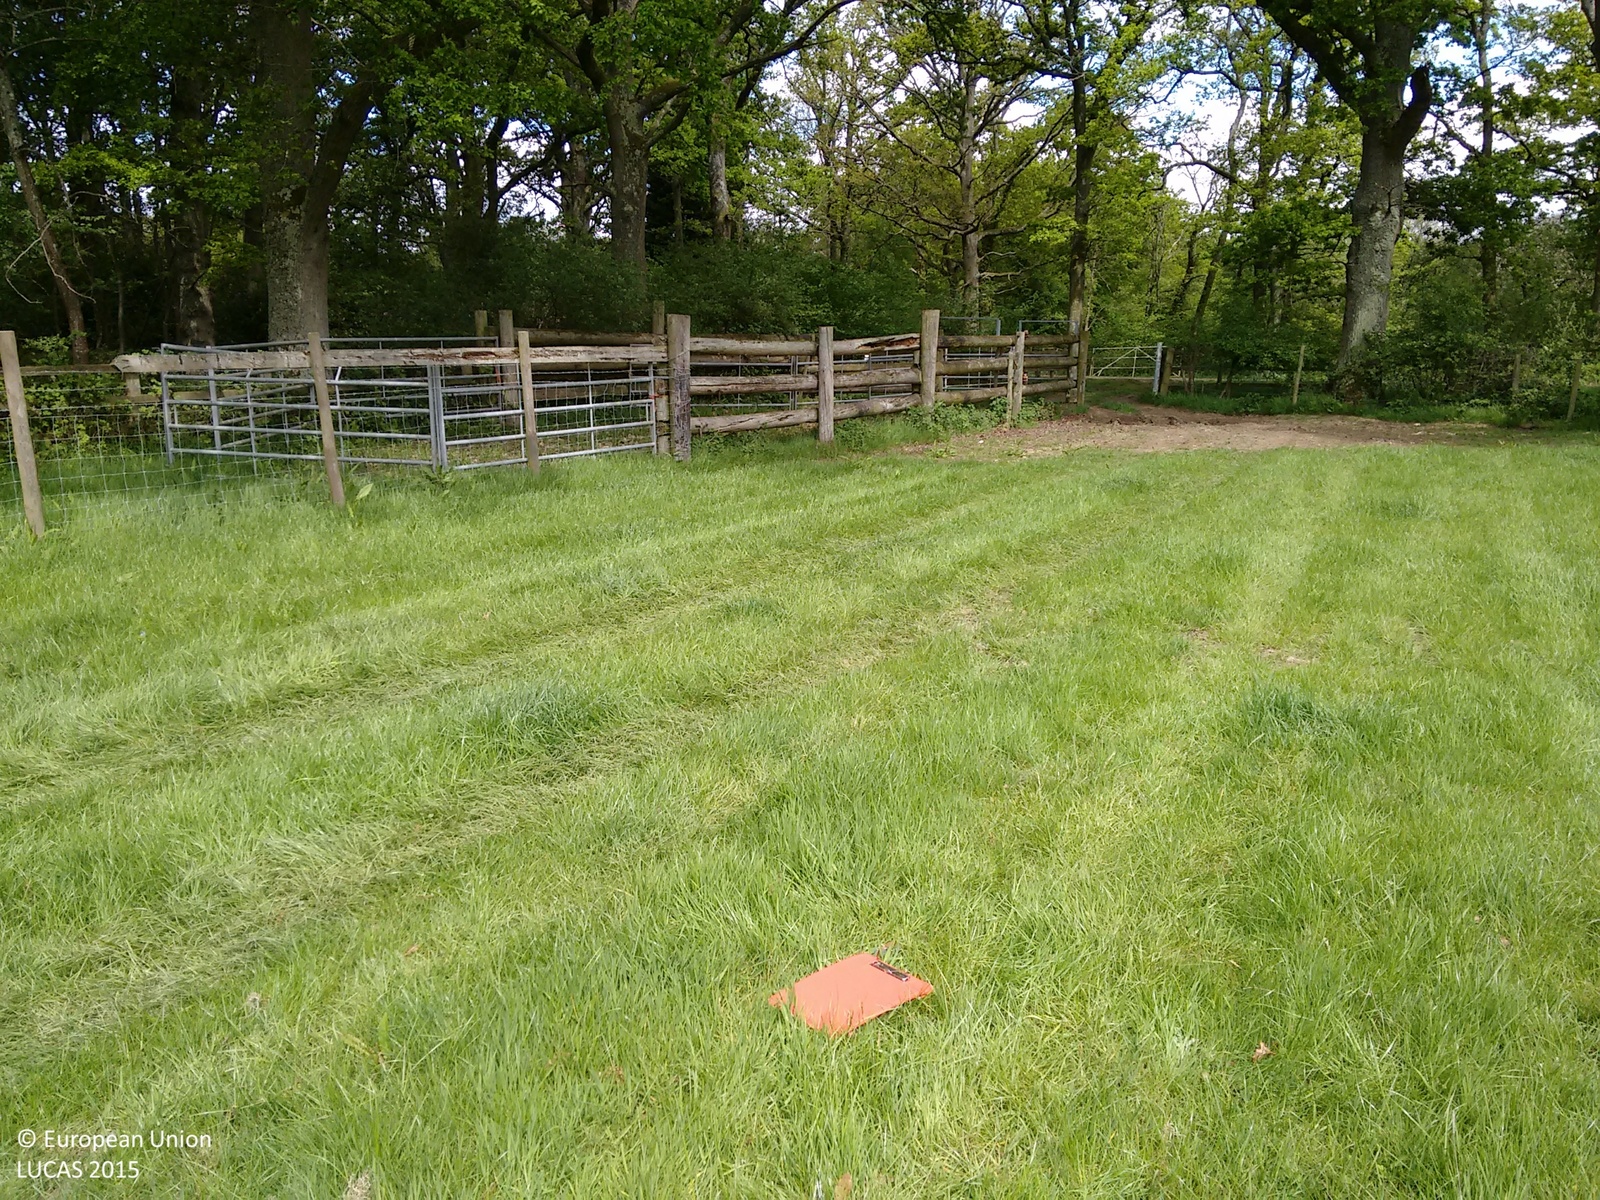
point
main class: Grassland
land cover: Grassland without tree/shrub cover
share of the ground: > 75 %
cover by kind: herbaceous plants 100 %
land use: Agriculture (excluding fallow land and kitchen gardens)
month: May
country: GB
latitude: 51.3249
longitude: -1.1392
